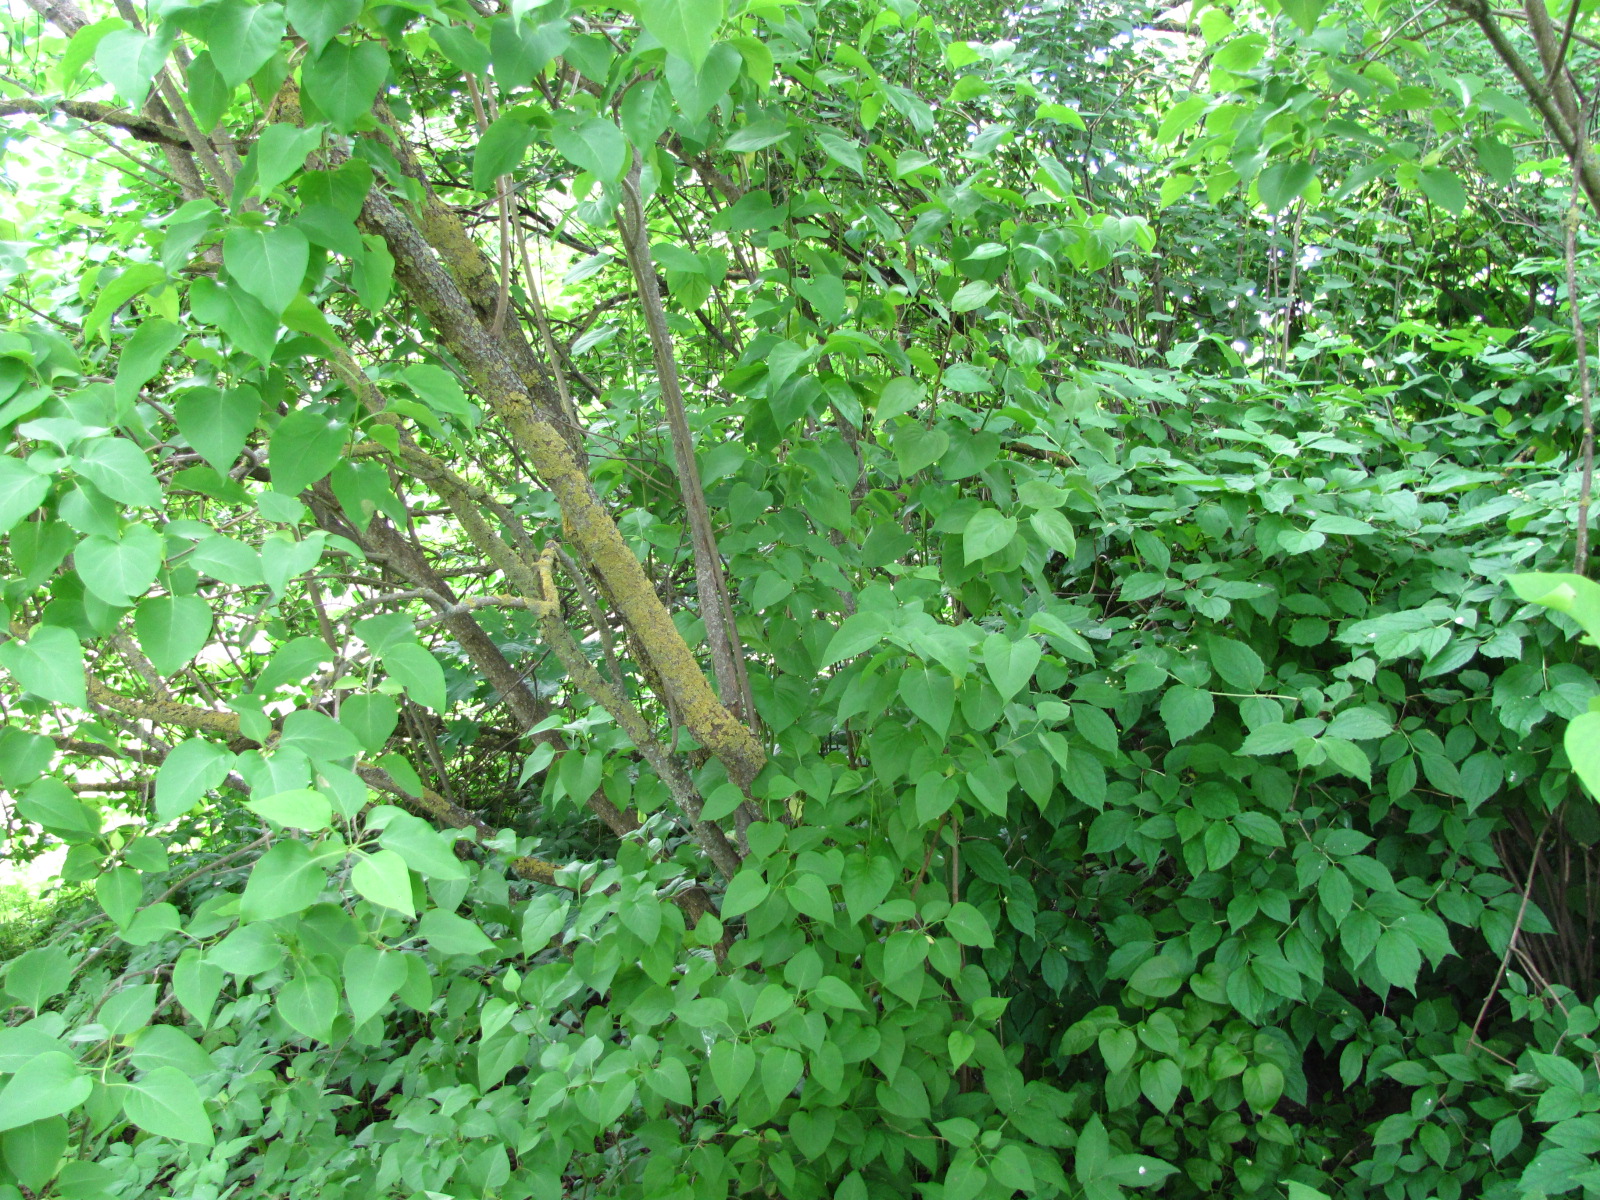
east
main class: Woodland
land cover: Broadleaved woodland
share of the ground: > 75 %
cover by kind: broadleaved forest trees 80 %, herbaceous plants 20 %
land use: Residential
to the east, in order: Broadleaved woodland; Grassland with sparse tree/shrub cover; Electric lines; Broadleaved woodland; Common wheat; Grass margins; Paved roads, cycling and walking lanes
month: June
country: LV
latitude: 56.3562
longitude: 24.0868
